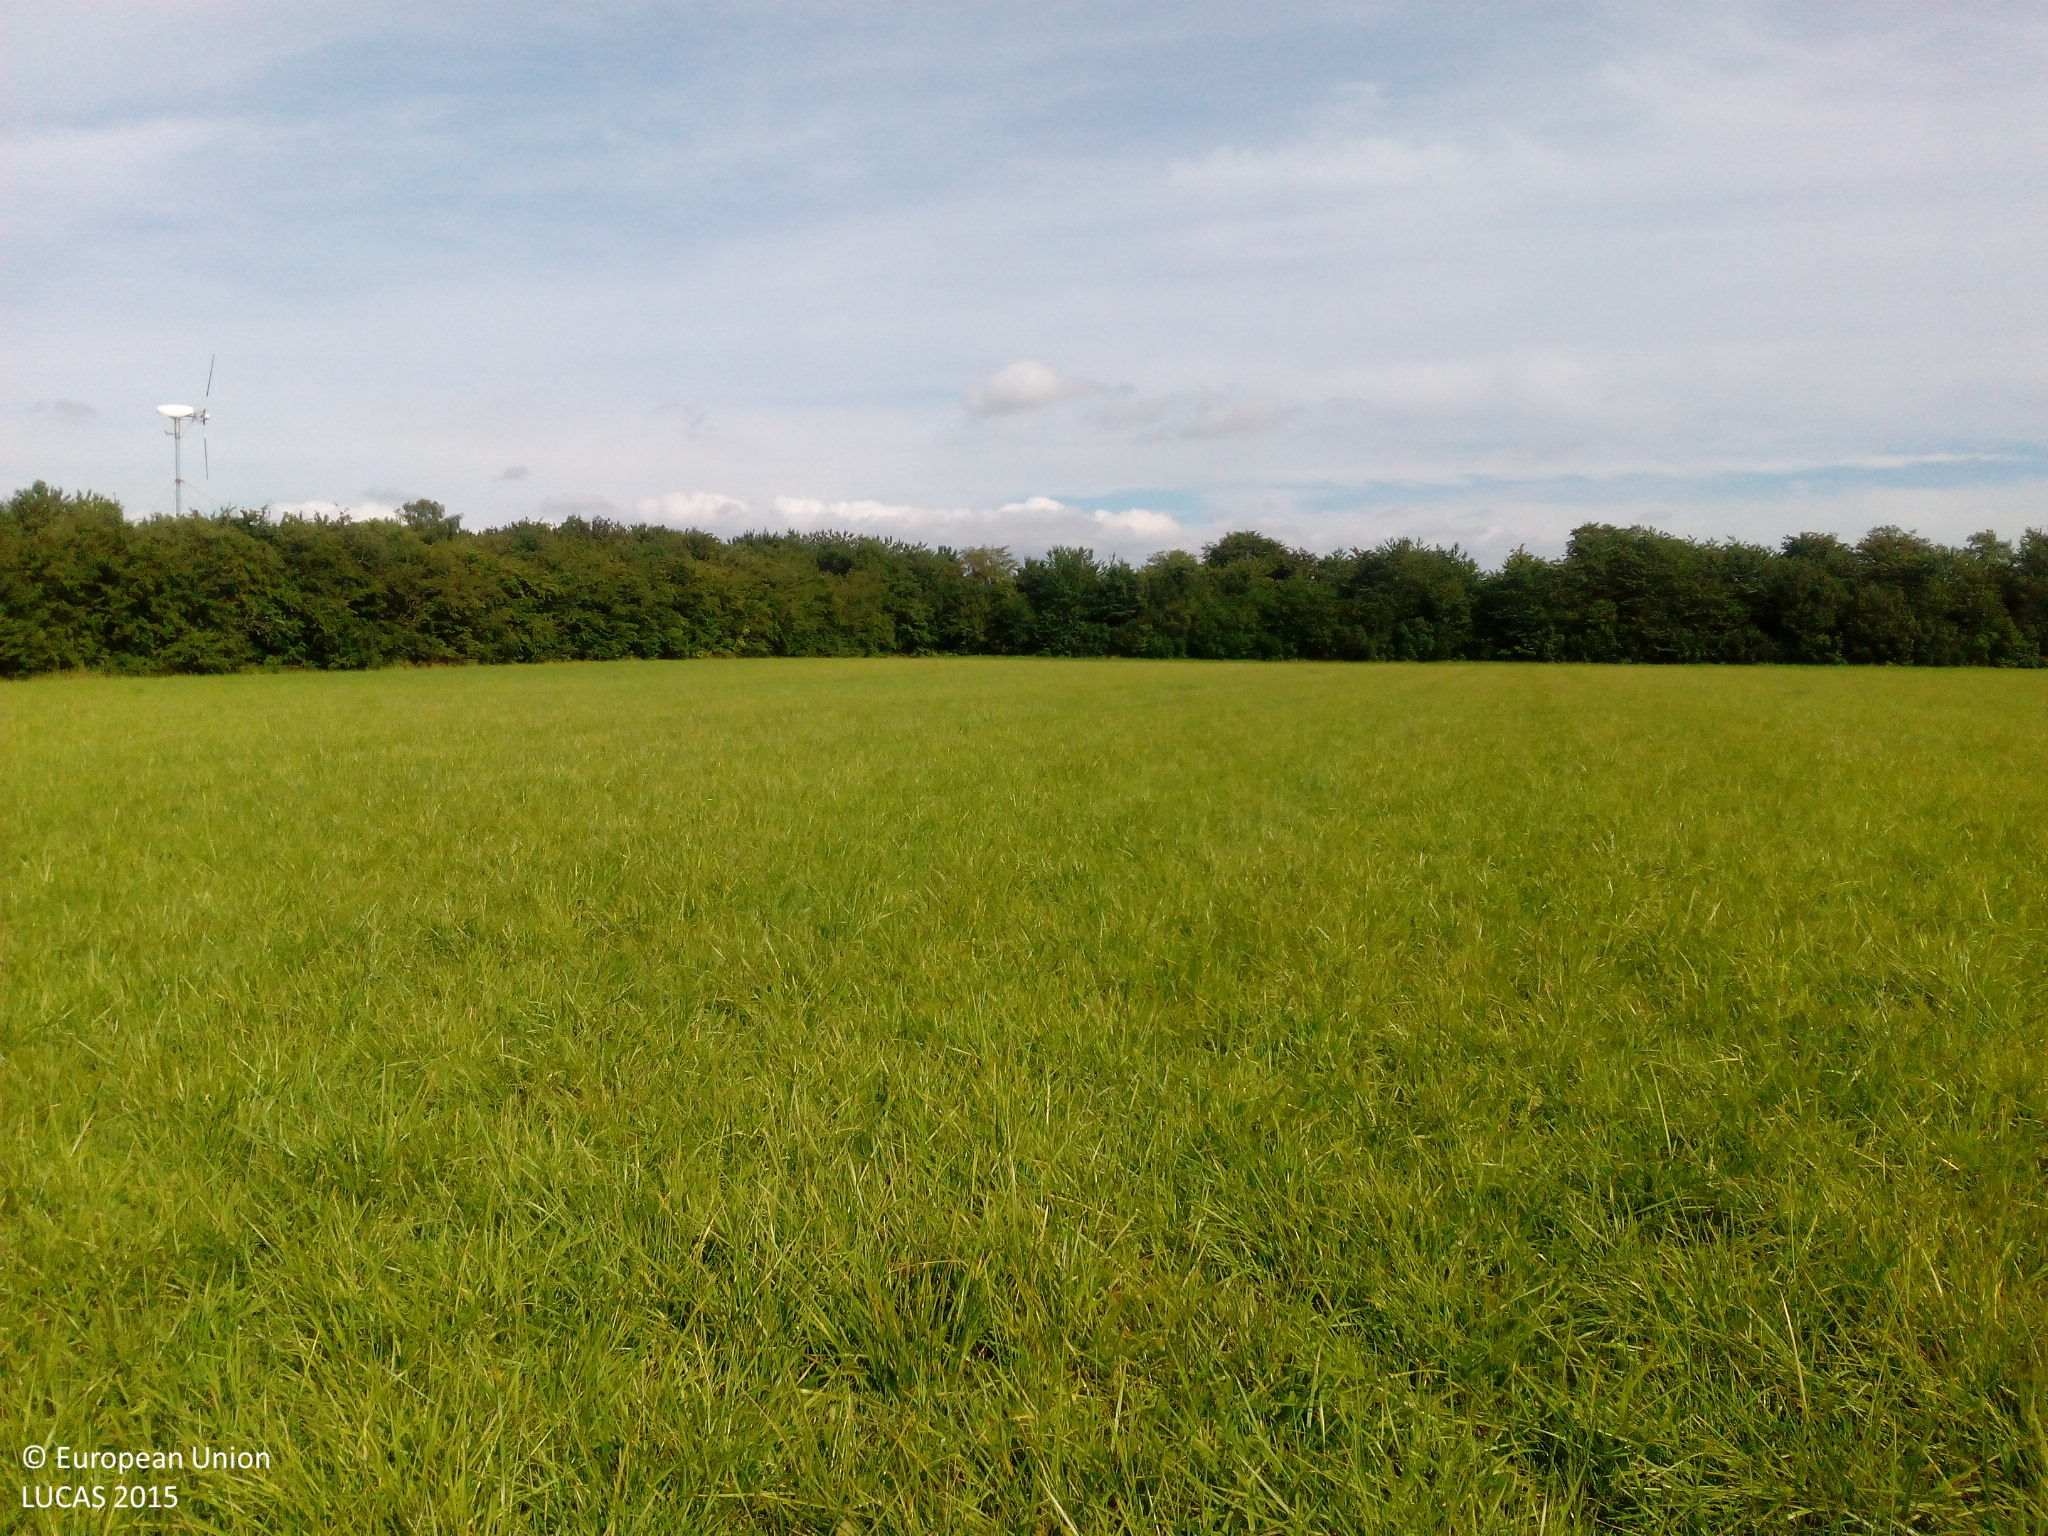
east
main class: Grassland
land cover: Grassland without tree/shrub cover
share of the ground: > 75 %
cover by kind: herbaceous plants 100 %
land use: Agriculture (excluding fallow land and kitchen gardens)
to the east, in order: Grassland without tree/shrub cover; Broadleaved woodland; Grass margins; Electric lines; Railways; Electric lines; Grass margins; Broadleaved woodland; Temporary grasslands
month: August
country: DK
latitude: 55.6140
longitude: 12.0464
